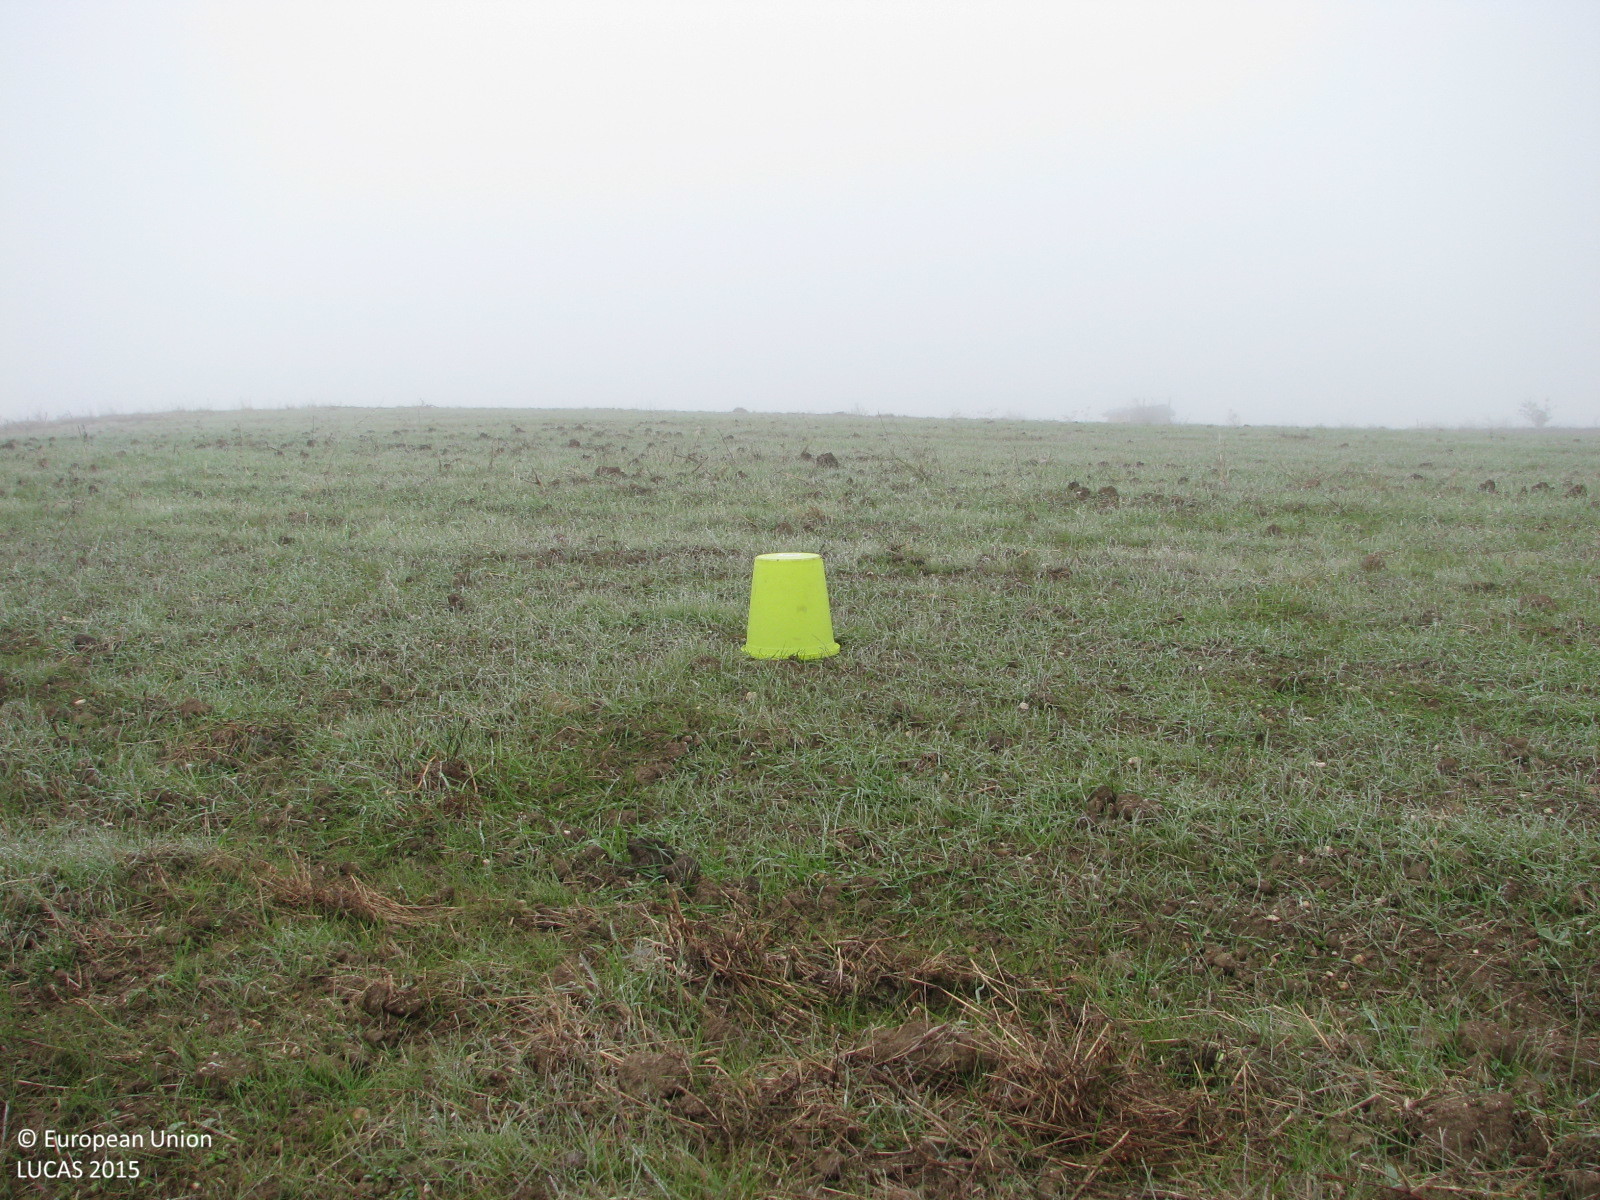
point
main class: Grassland
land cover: Spontaneously vegetated surfaces
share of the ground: > 75 %
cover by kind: herbaceous plants 100 %
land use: Agriculture (excluding fallow land and kitchen gardens)
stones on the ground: < 10 %
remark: Harvested field
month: November
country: BG
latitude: 42.1075
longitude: 26.6709
